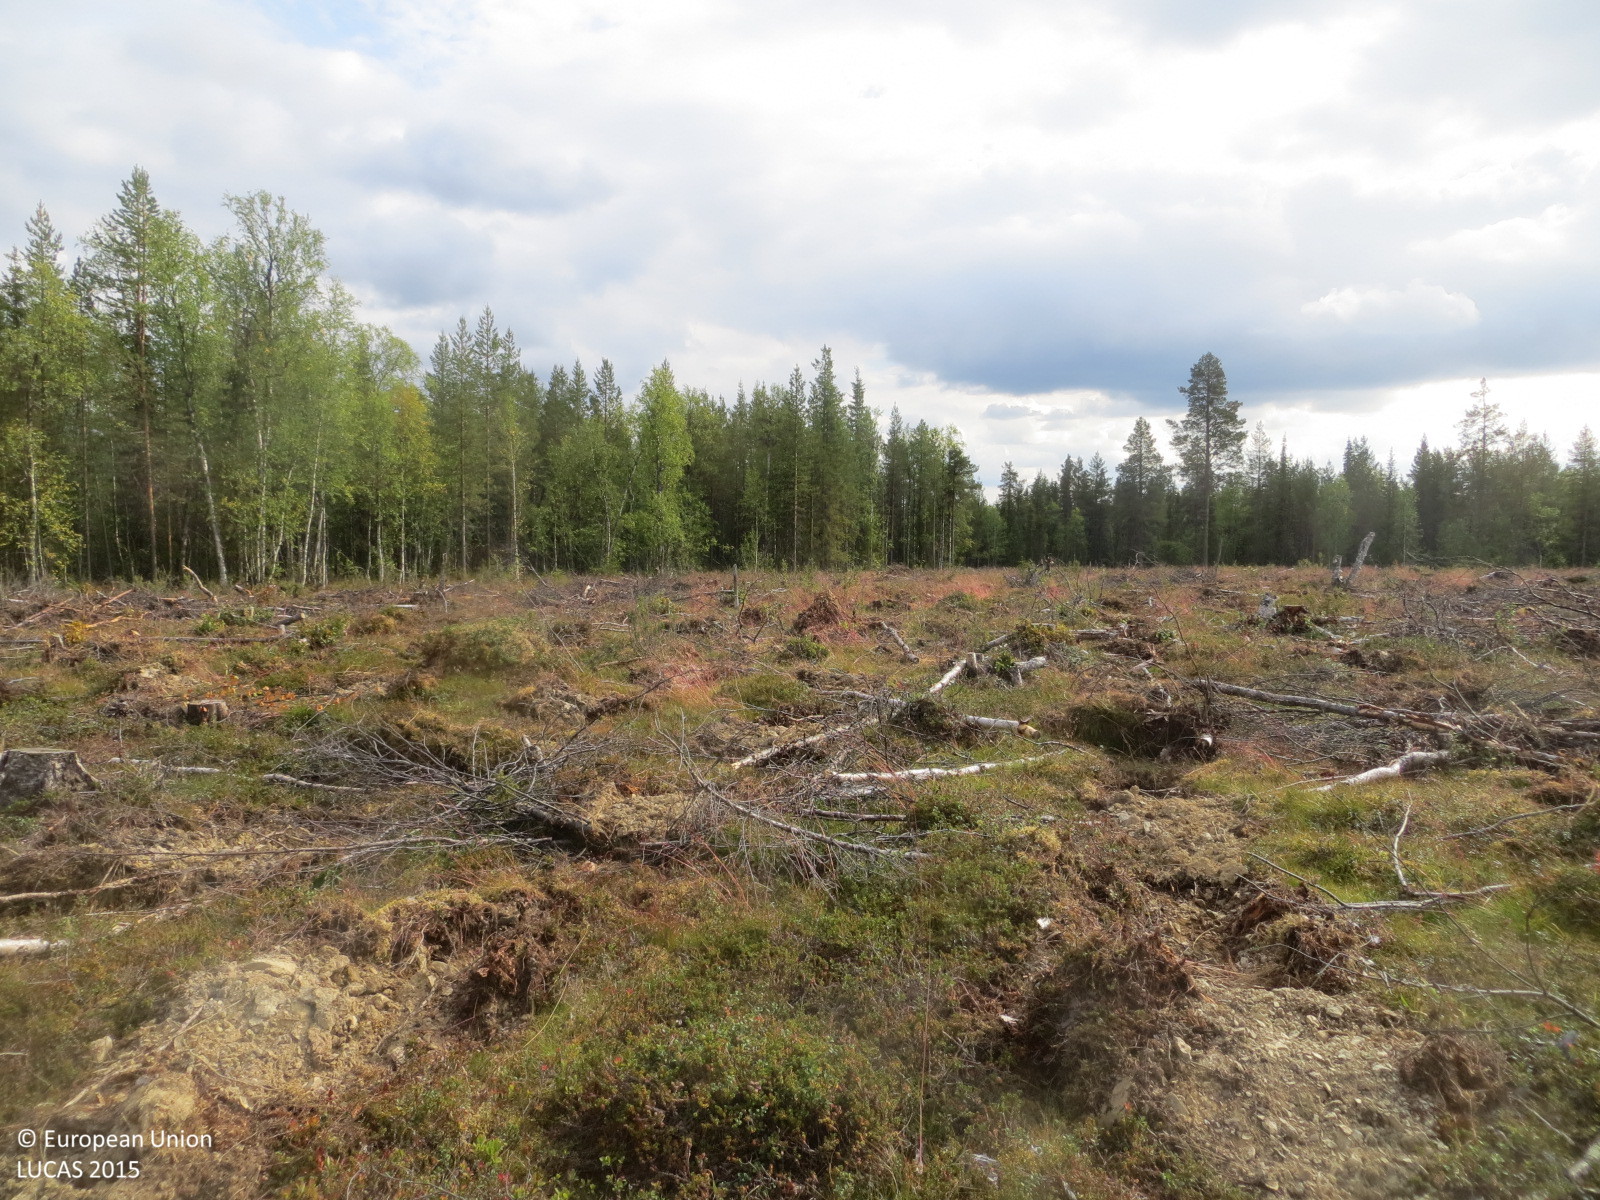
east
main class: Shrubland
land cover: Shrubland with sparse tree cover
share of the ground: > 75 %
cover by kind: shrubs 70 %, unconsolidated bare surface 10 %, coniferous forest trees 5 %, consolidated bare surface 5 %
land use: Forestry
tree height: > 5 m
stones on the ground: 25 - 50 %
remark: Clear cut
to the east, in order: Shrubland with sparse tree cover; Other mixed woodland; Pine dominated coniferous woodland; Spruce dominated mixed woodland
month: August
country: FI
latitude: 67.9312
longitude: 25.4728
